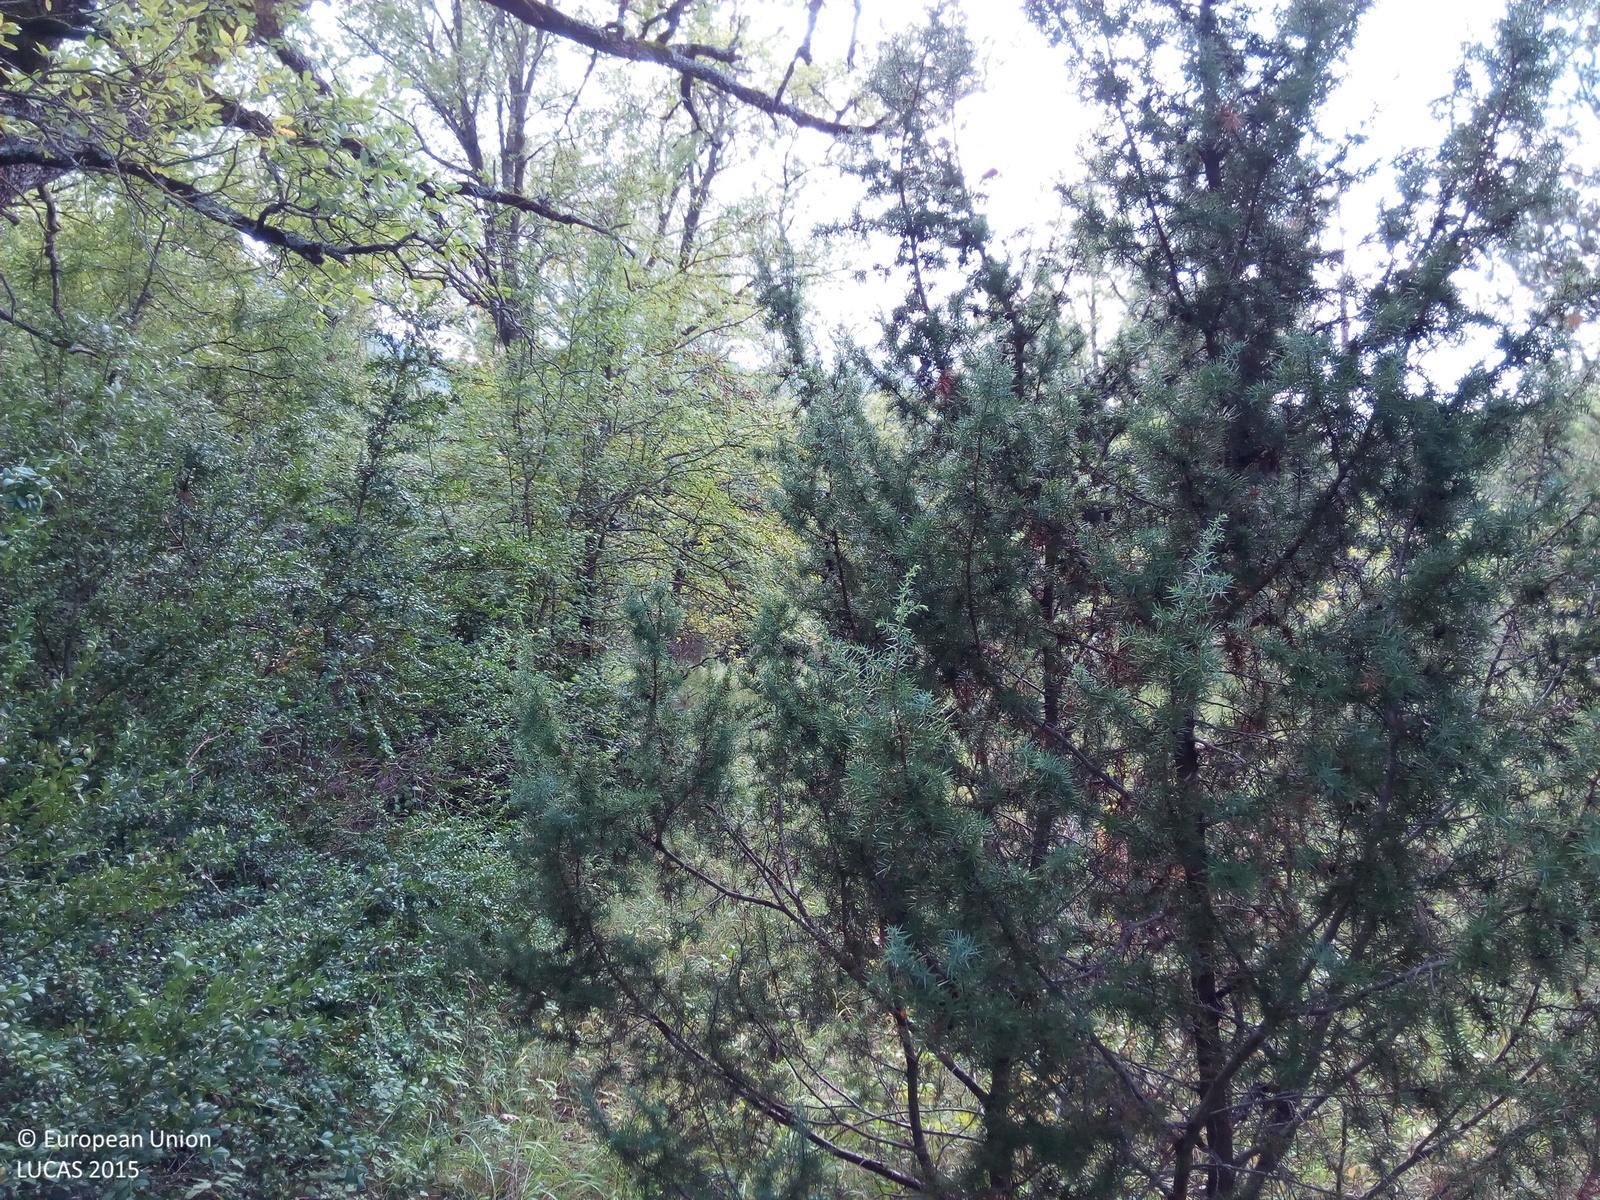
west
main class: Woodland
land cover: Broadleaved woodland
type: broadleaved evergreen forest
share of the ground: > 75 %
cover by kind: broadleaved forest trees 100 %
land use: Semi-natural and natural areas not in use
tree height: > 5 m
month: September
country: ES
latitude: 42.4639
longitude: -0.0316
